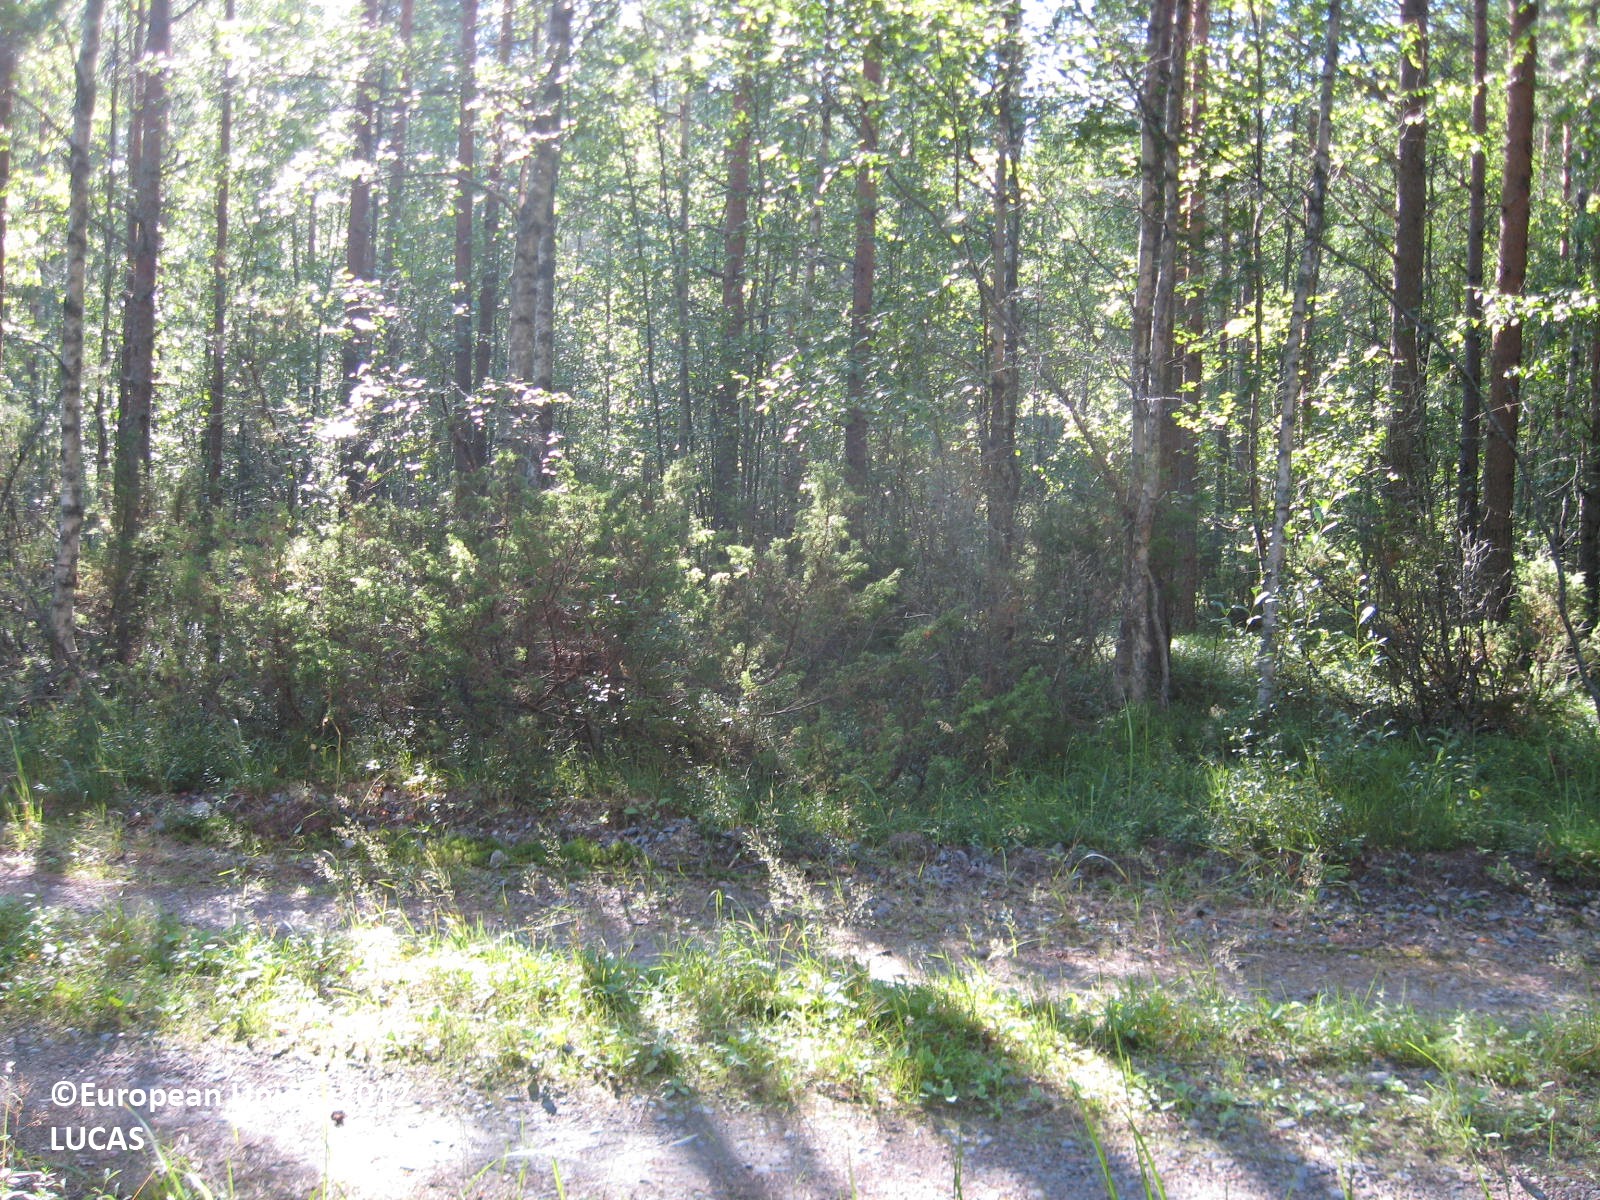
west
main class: Woodland
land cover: Pine dominated mixed woodland
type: boreal forest
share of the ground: > 75 %
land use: Forestry
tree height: > 5 m
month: July
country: FI
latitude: 61.9504
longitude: 22.6242
